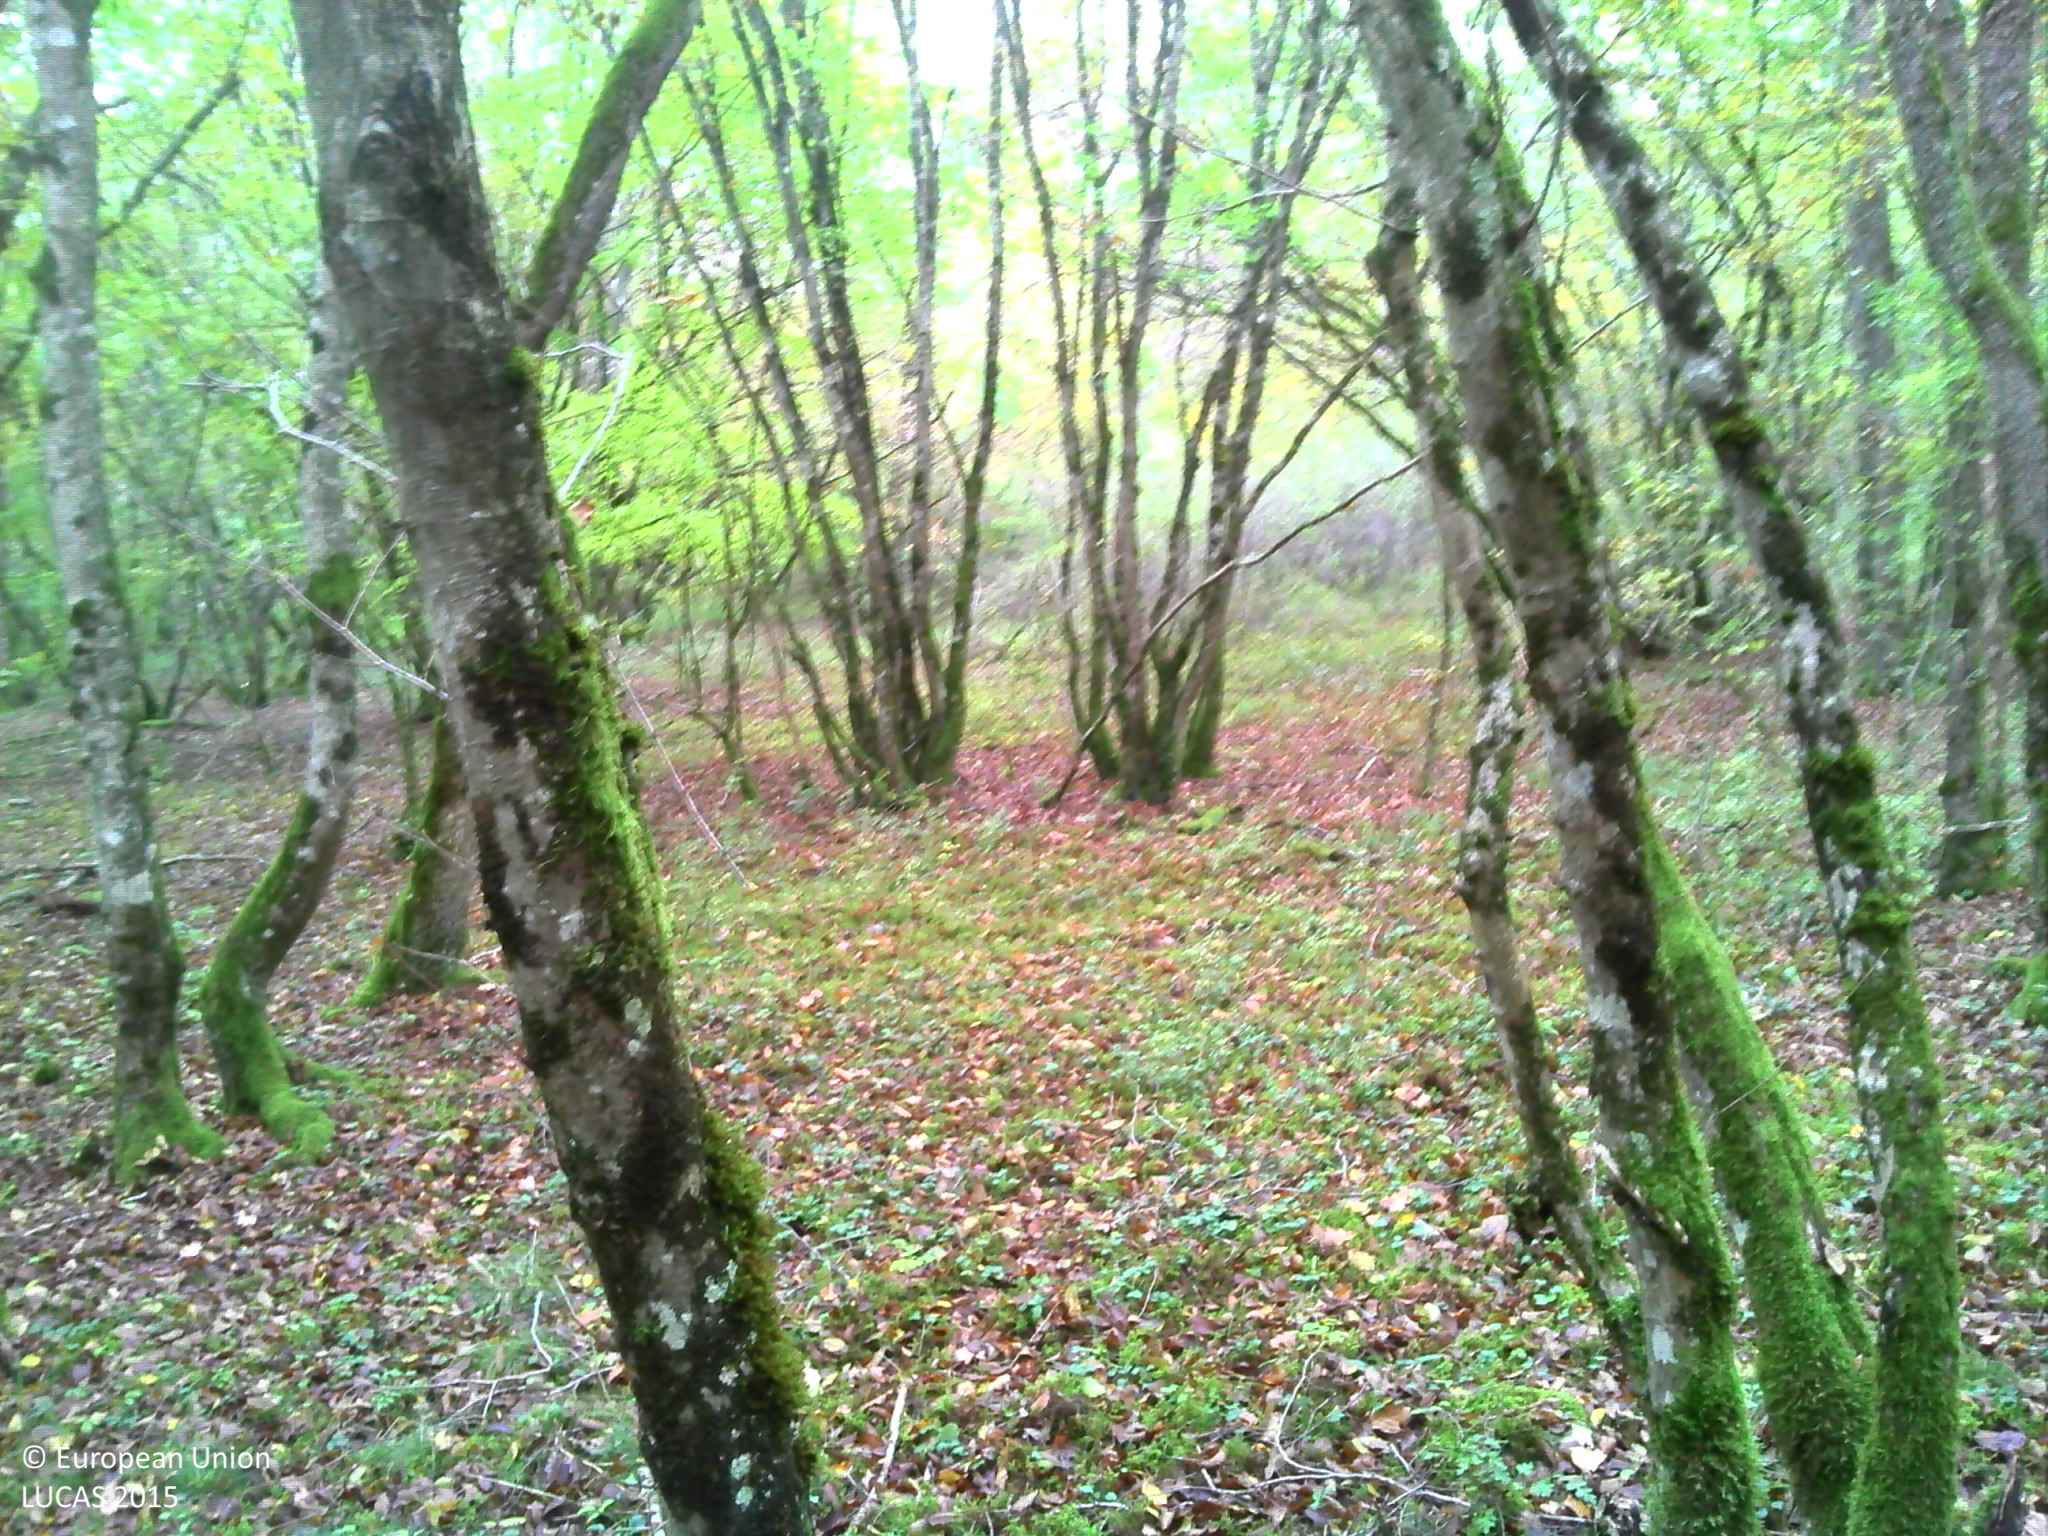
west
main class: Woodland
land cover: Broadleaved woodland
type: mesophytic deciduous forest
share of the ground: > 75 %
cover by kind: broadleaved forest trees 90 %, herbaceous plants 10 %
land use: Forestry
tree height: > 5 m
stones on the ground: < 10 %
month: October
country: FR
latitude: 47.5328
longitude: 4.9921
